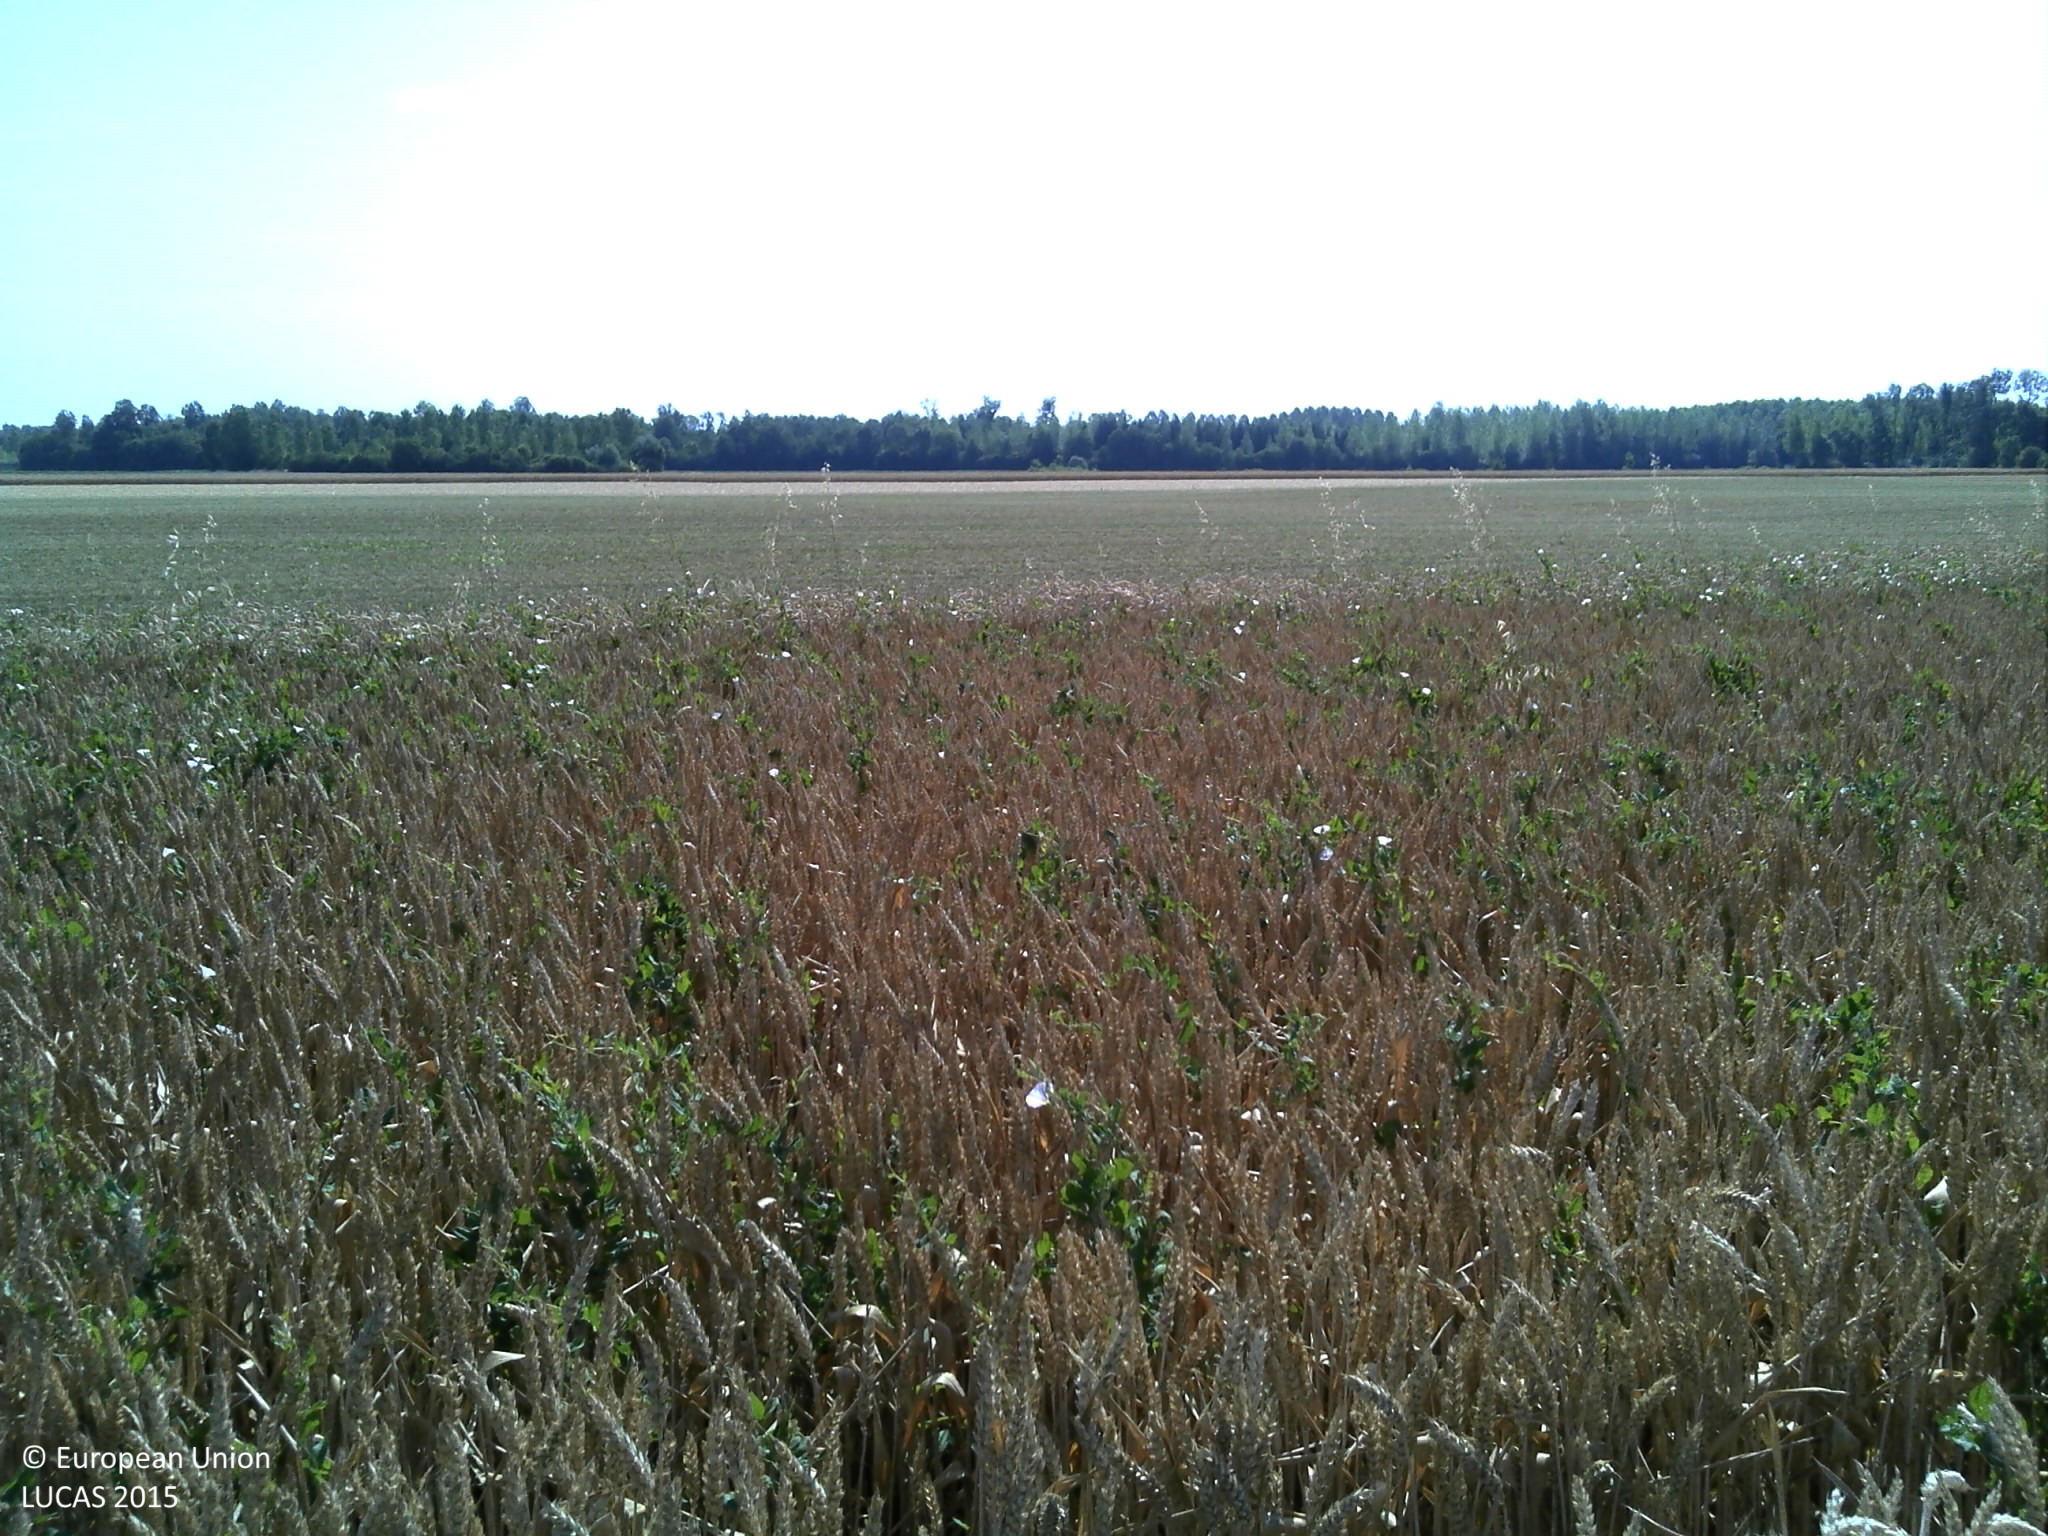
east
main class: Cropland
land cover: Common wheat
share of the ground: > 75 %
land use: Agriculture (excluding fallow land and kitchen gardens)
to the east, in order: Common wheat; Lucerne; Common wheat
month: July
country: FR
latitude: 48.7878
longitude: 4.8392
